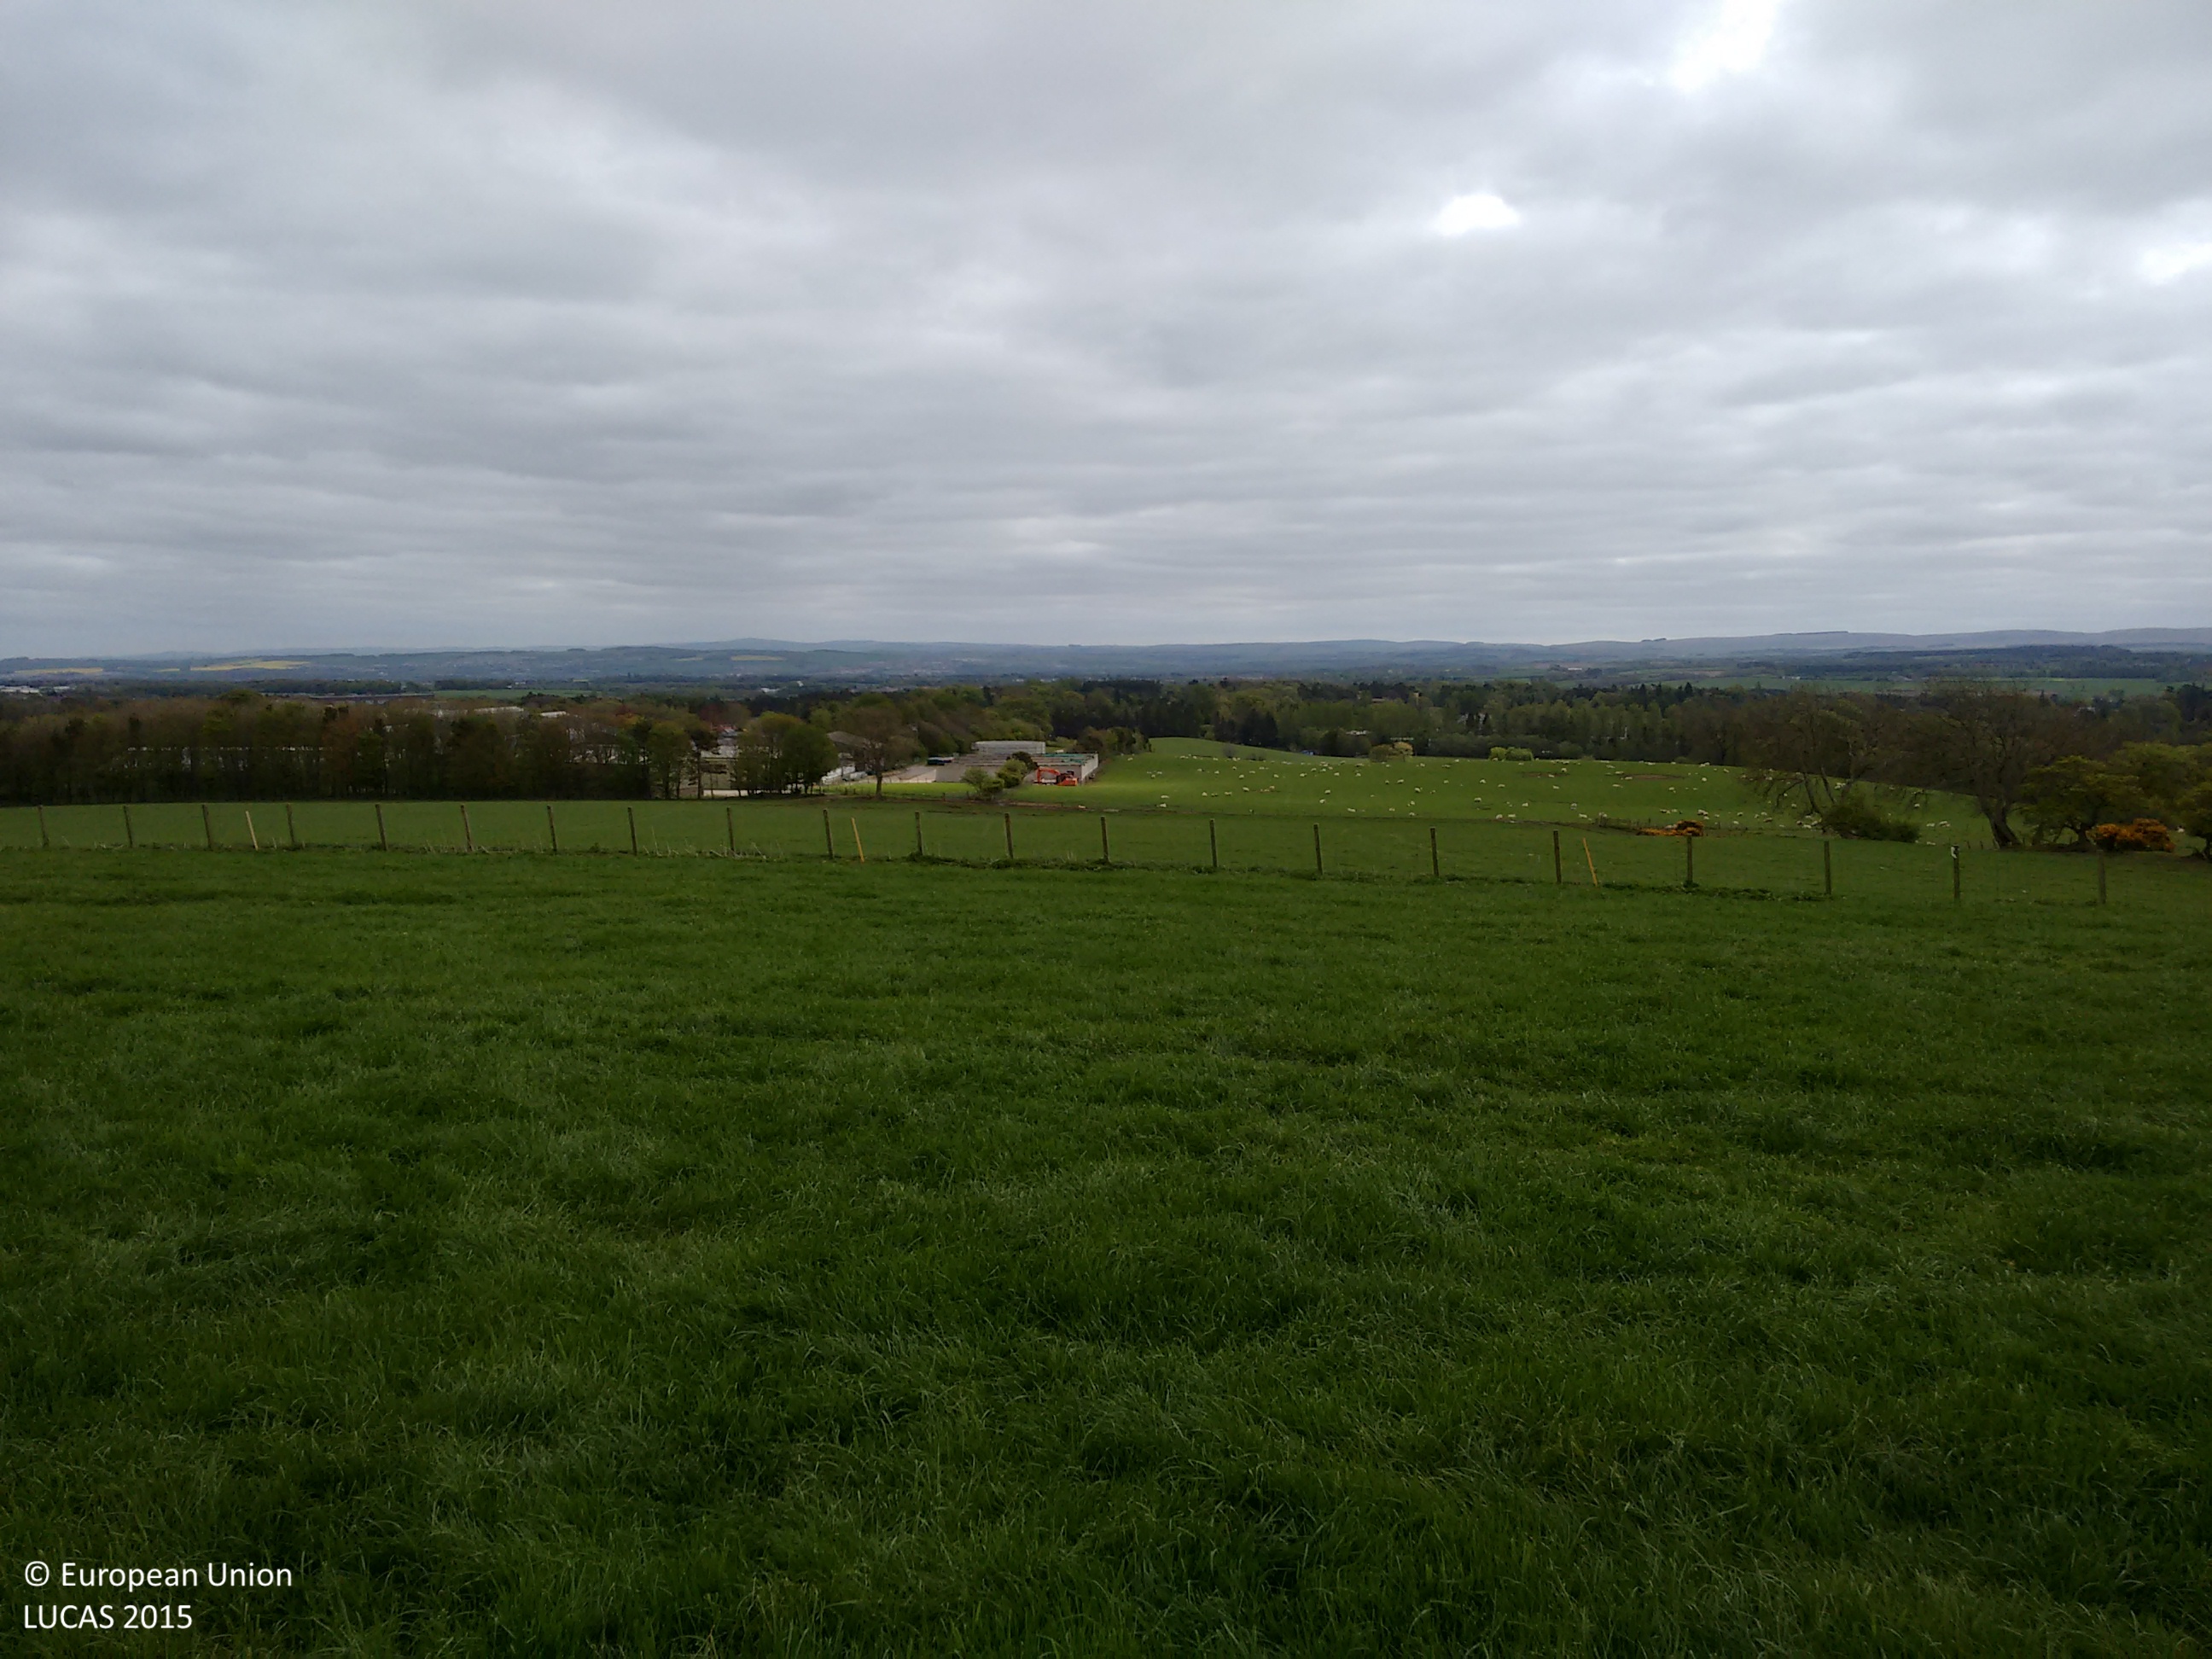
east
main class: Grassland
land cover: Grassland without tree/shrub cover
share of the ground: > 75 %
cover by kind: herbaceous plants 100 %
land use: Agriculture (excluding fallow land and kitchen gardens)
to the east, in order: Grassland without tree/shrub cover; Fences; Grassland without tree/shrub cover
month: May
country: GB
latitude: 55.8644
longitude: -3.2230
